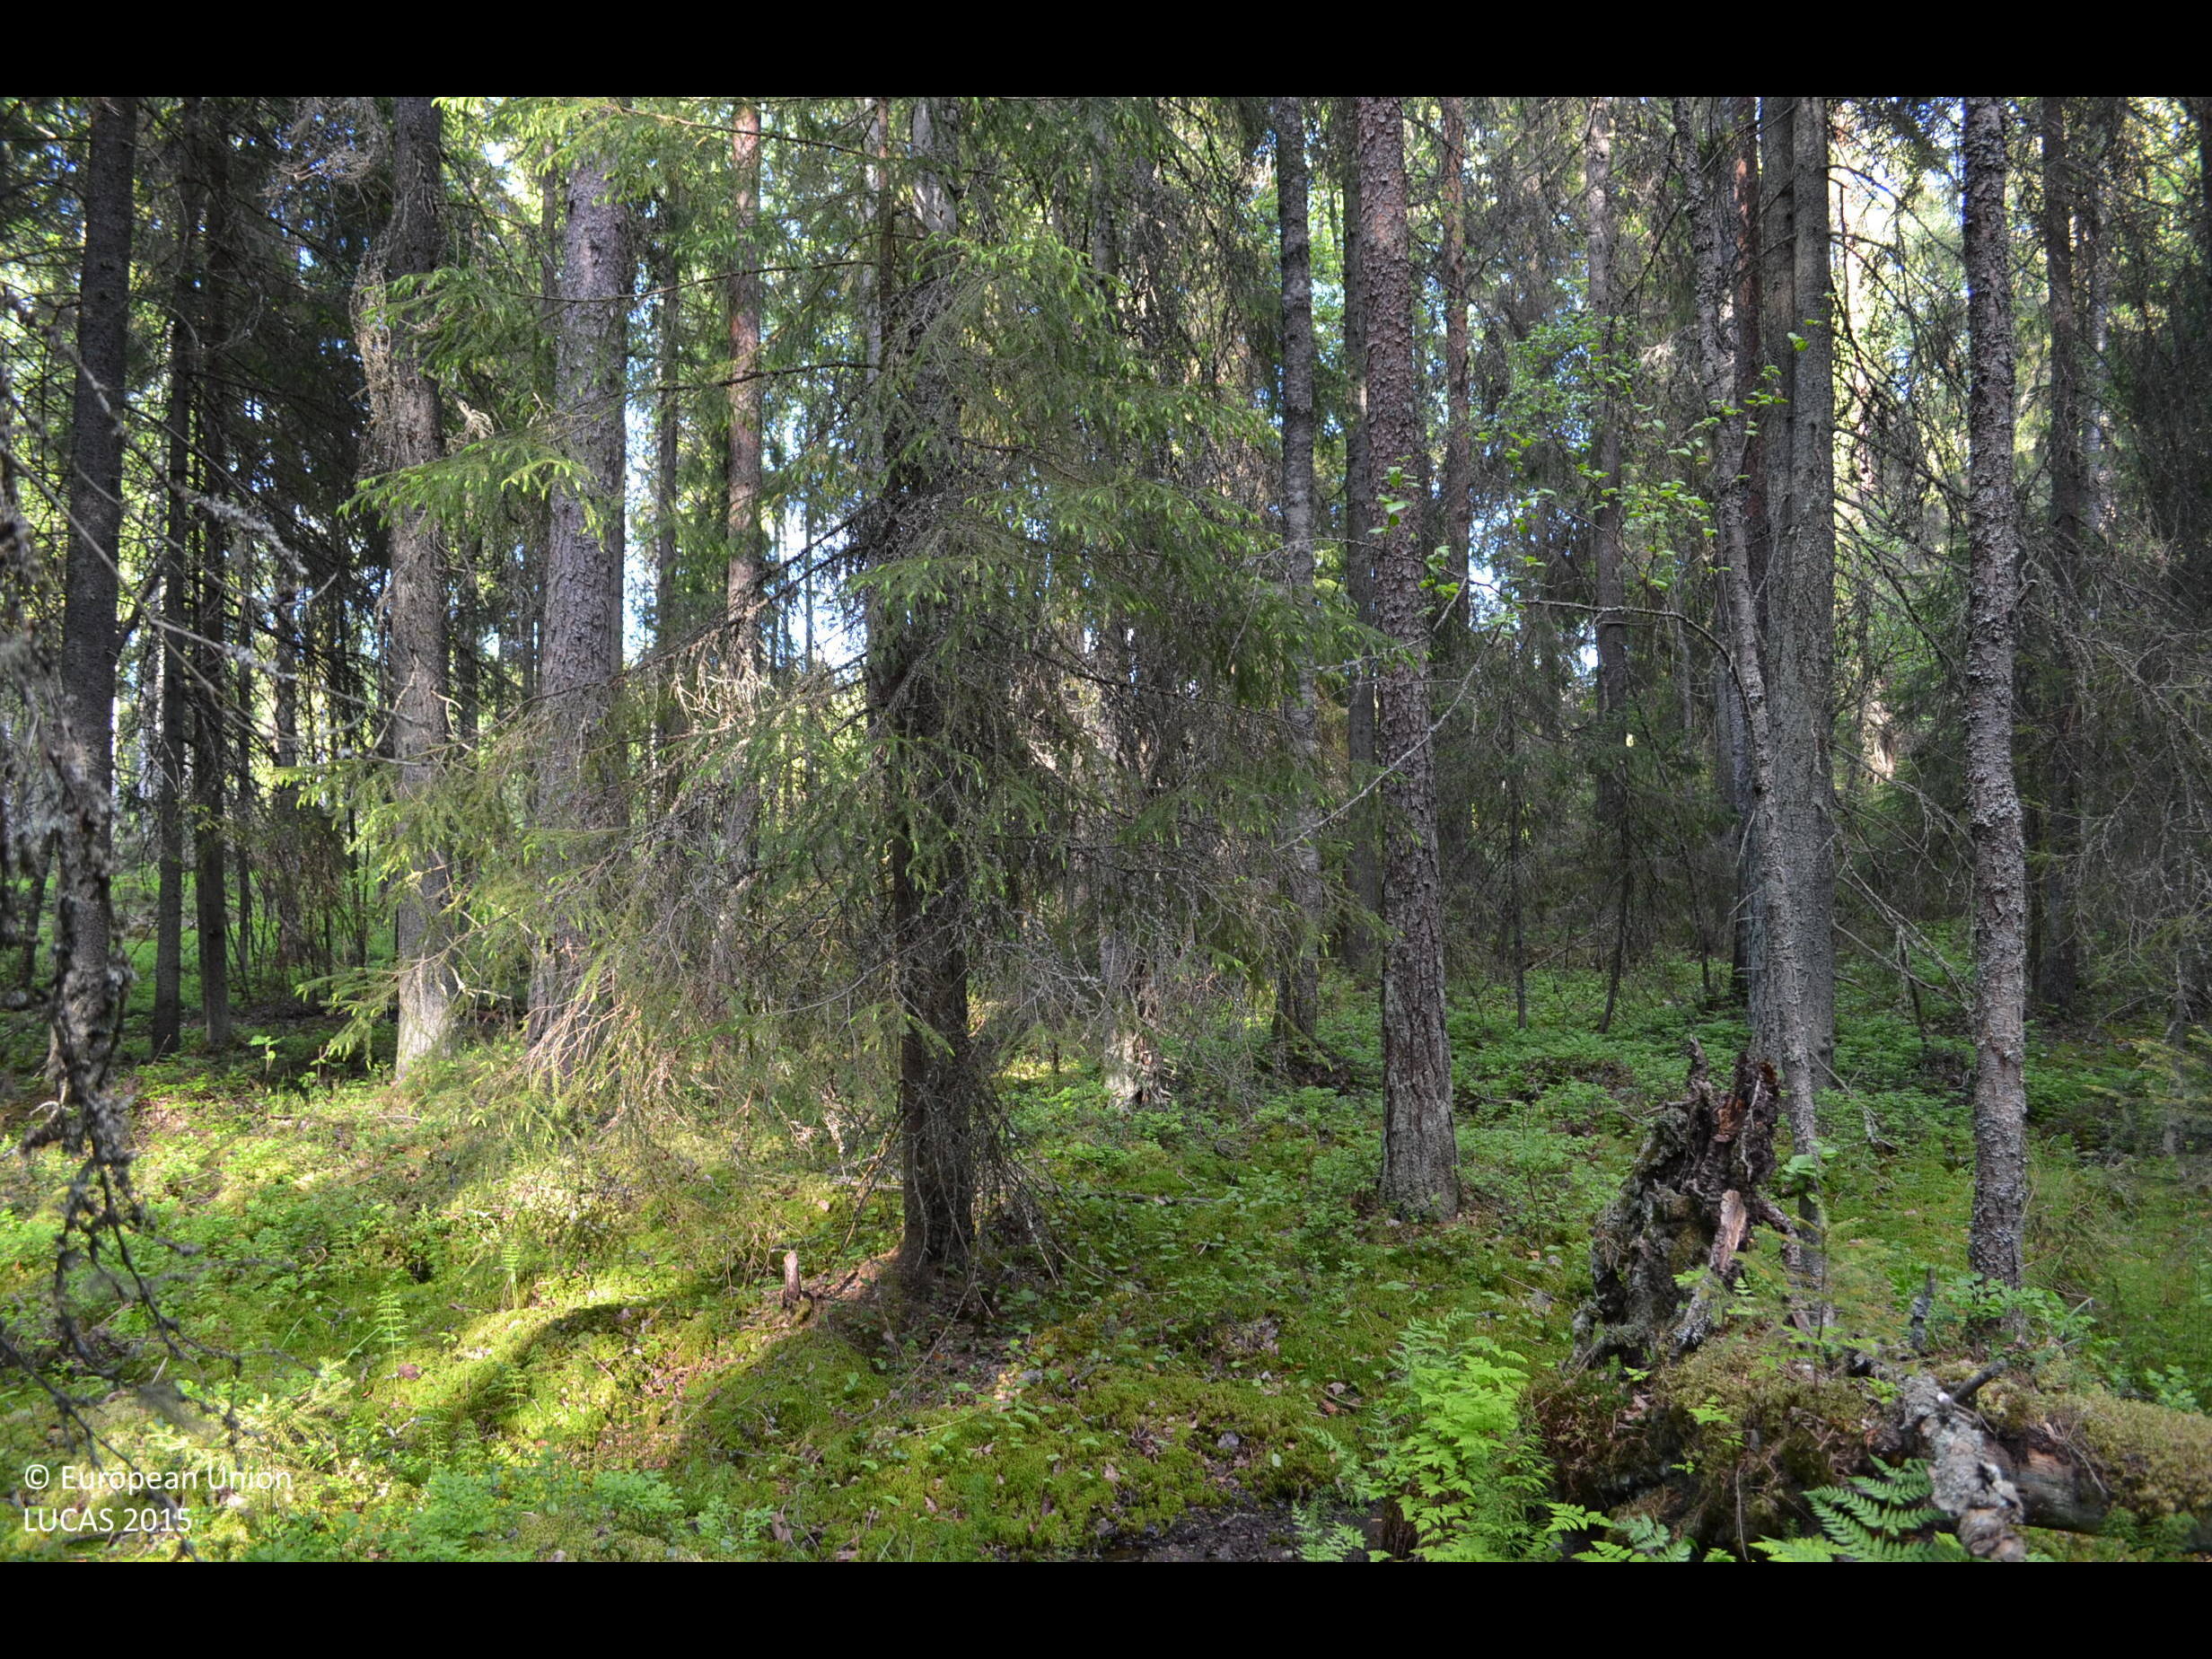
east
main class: Woodland
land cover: Spruce dominated coniferous woodland
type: boreal forest
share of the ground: > 75 %
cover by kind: coniferous forest trees 70 %, lichens and mosses 15 %, broadleaved forest trees 5 %, shrubs 5 %, herbaceous plants 5 %
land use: Forestry
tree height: > 5 m
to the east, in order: Spruce dominated coniferous woodland; Shrubland with sparse tree cover; Electric lines; Grass margins; Ditches and canals; Paved roads, cycling and walking lanes
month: June
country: FI
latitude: 61.6474
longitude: 23.1535
